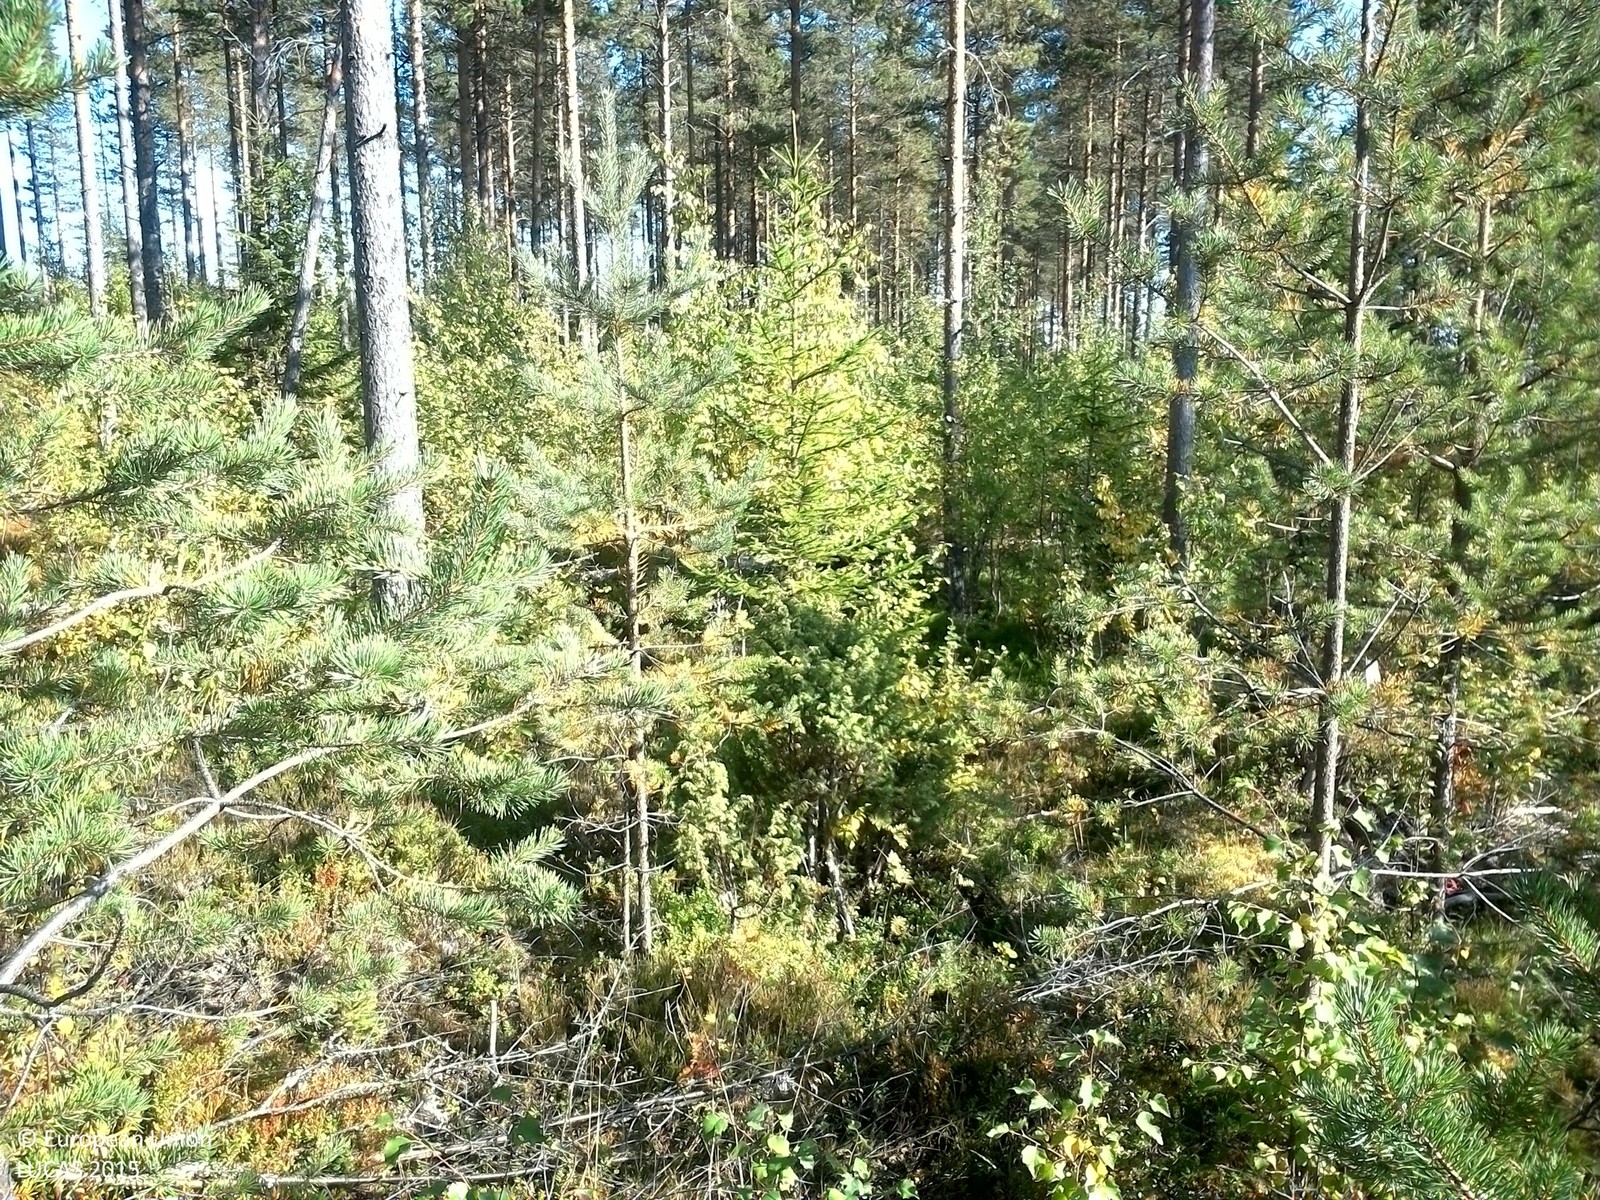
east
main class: Woodland
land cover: Pine dominated mixed woodland
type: boreal forest
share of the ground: 50 - 75 %
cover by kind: coniferous forest trees 35 %, shrubs 30 %, broadleaved forest trees 15 %, herbaceous plants 10 %, lichens and mosses 10 %
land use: Forestry
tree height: > 5 m
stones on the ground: 10 - 25 %
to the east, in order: Pine dominated mixed woodland; Pine dominated coniferous woodland; Pine dominated mixed woodland
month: September
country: SE
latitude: 61.7718
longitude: 14.9678
